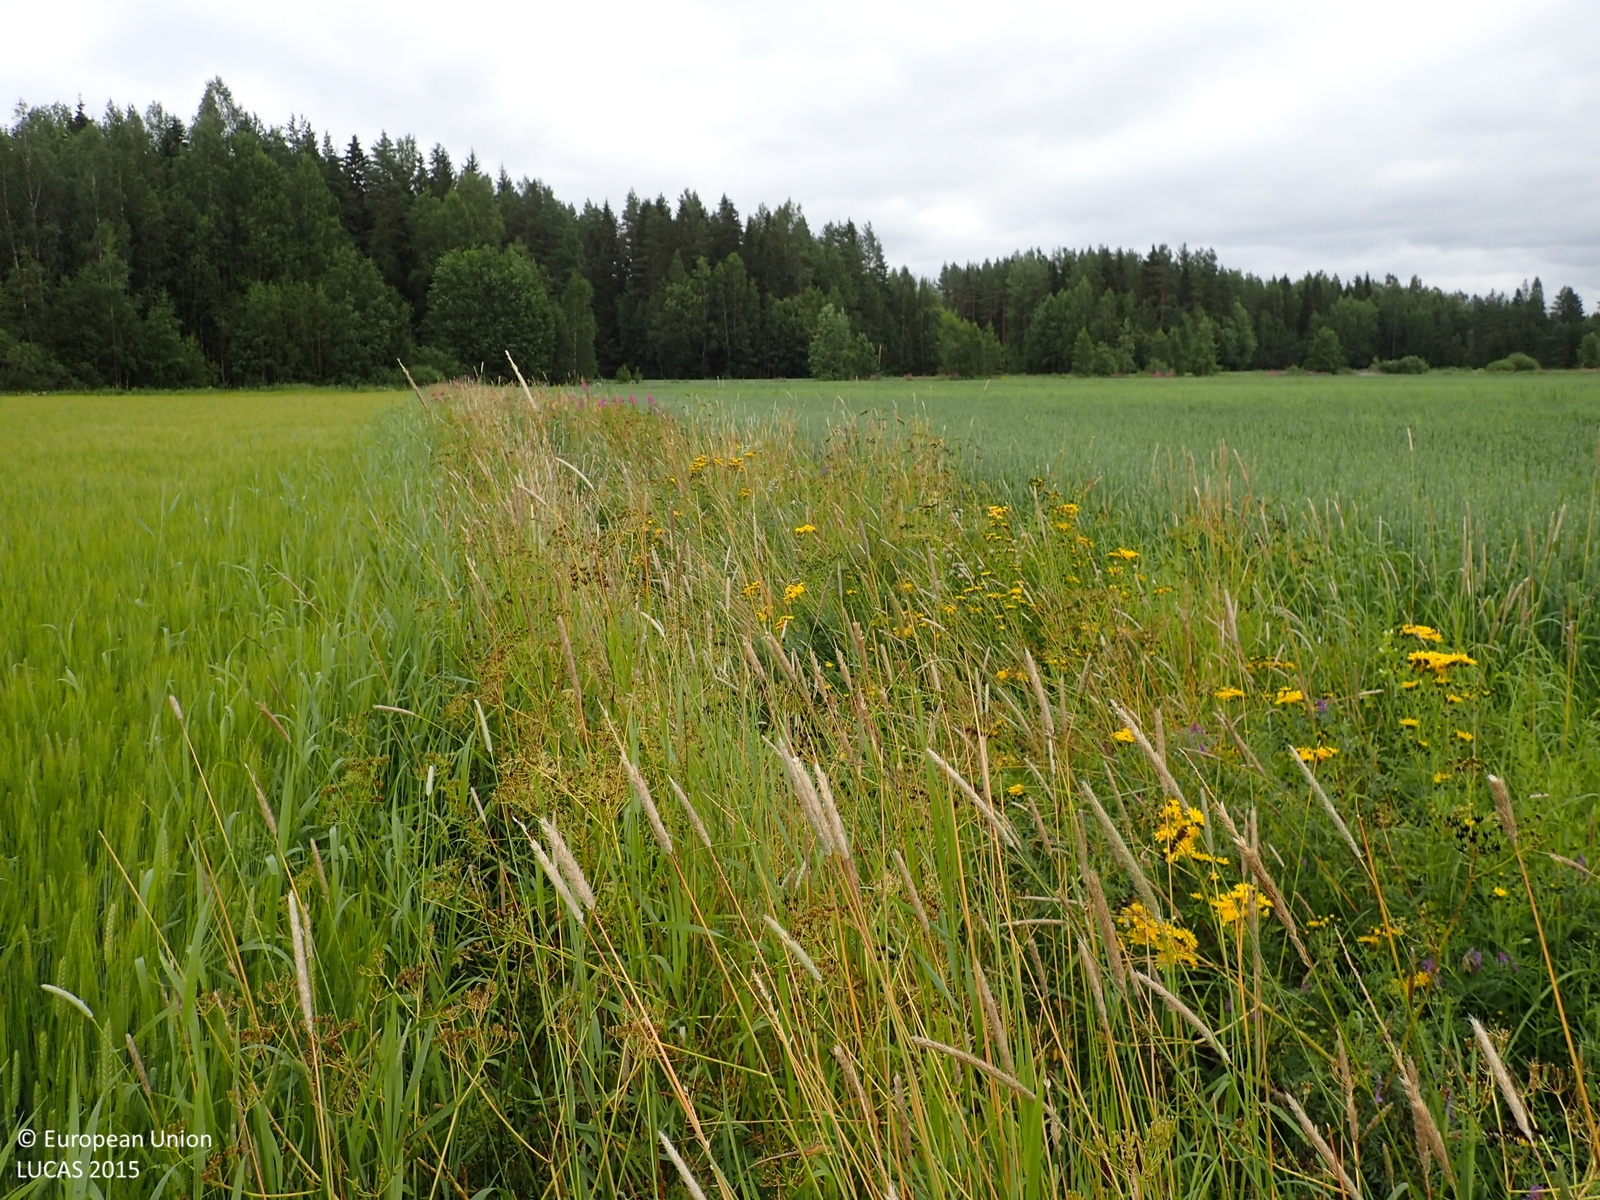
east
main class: Cropland
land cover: Barley
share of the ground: > 75 %
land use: Agriculture (excluding fallow land and kitchen gardens)
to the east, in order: Barley; Shruby margins; Ditches and canals; Shruby margins; Common wheat; Shruby margins; Ditches and canals; Abandoned hedges; Common wheat; Pine dominated mixed woodland; Common wheat; Other mixed woodland; Common wheat
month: August
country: FI
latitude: 62.8753
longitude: 22.0591
